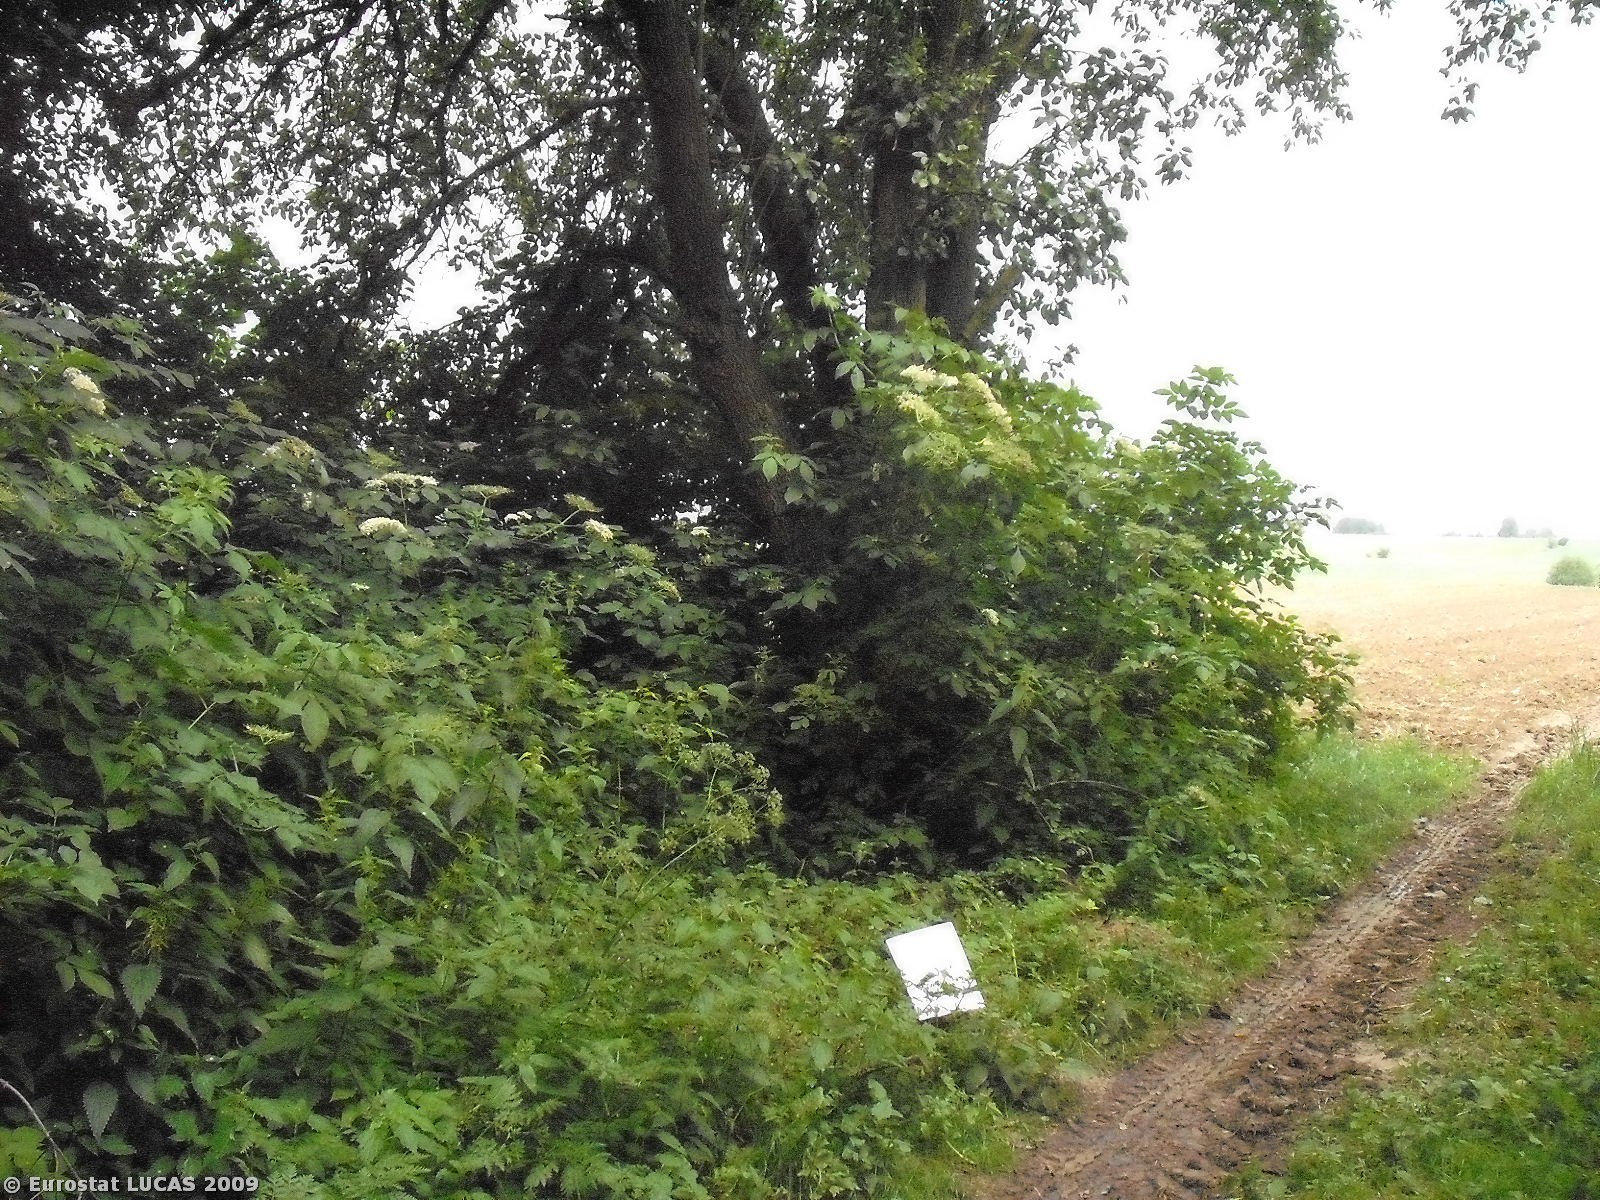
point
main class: Woodland
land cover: Broadleaved woodland
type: mesophytic deciduous forest
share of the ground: > 75 %
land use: Unused
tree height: > 5 m
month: June
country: PL
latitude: 50.7859
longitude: 21.2676
